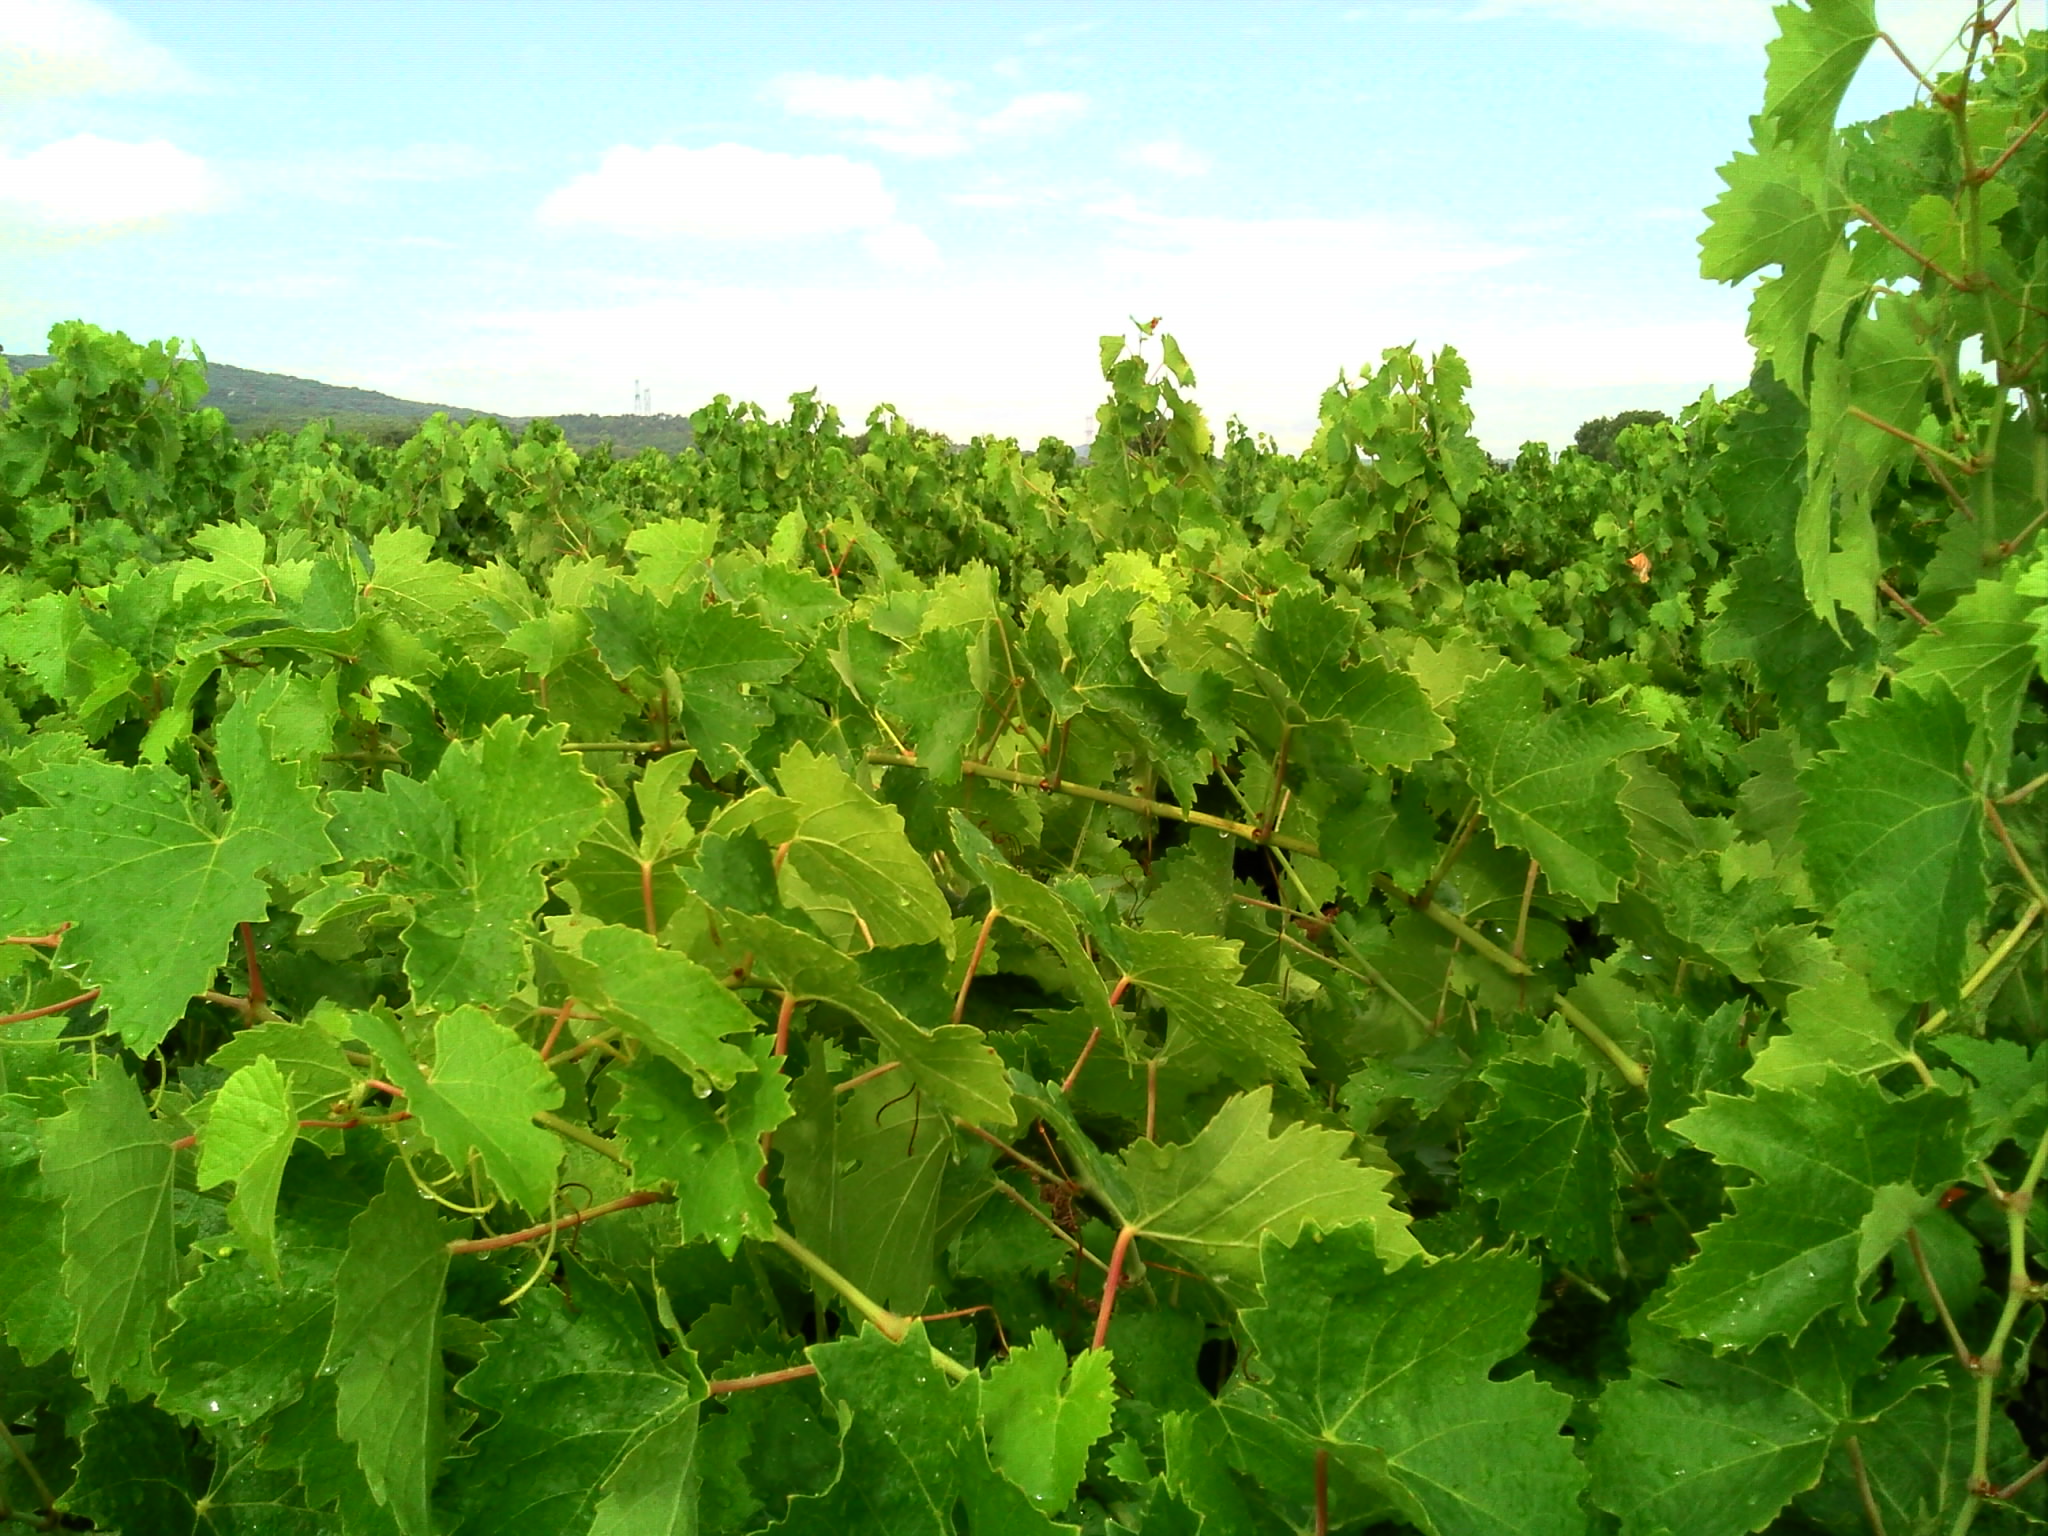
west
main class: Cropland
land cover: Vineyards
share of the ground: 25 - 50 %
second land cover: Spontaneously vegetated surfaces
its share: 50 - 75 %
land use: Agriculture (excluding fallow land and kitchen gardens)
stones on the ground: < 10 %
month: August
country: FR
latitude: 44.0681
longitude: 4.6520
